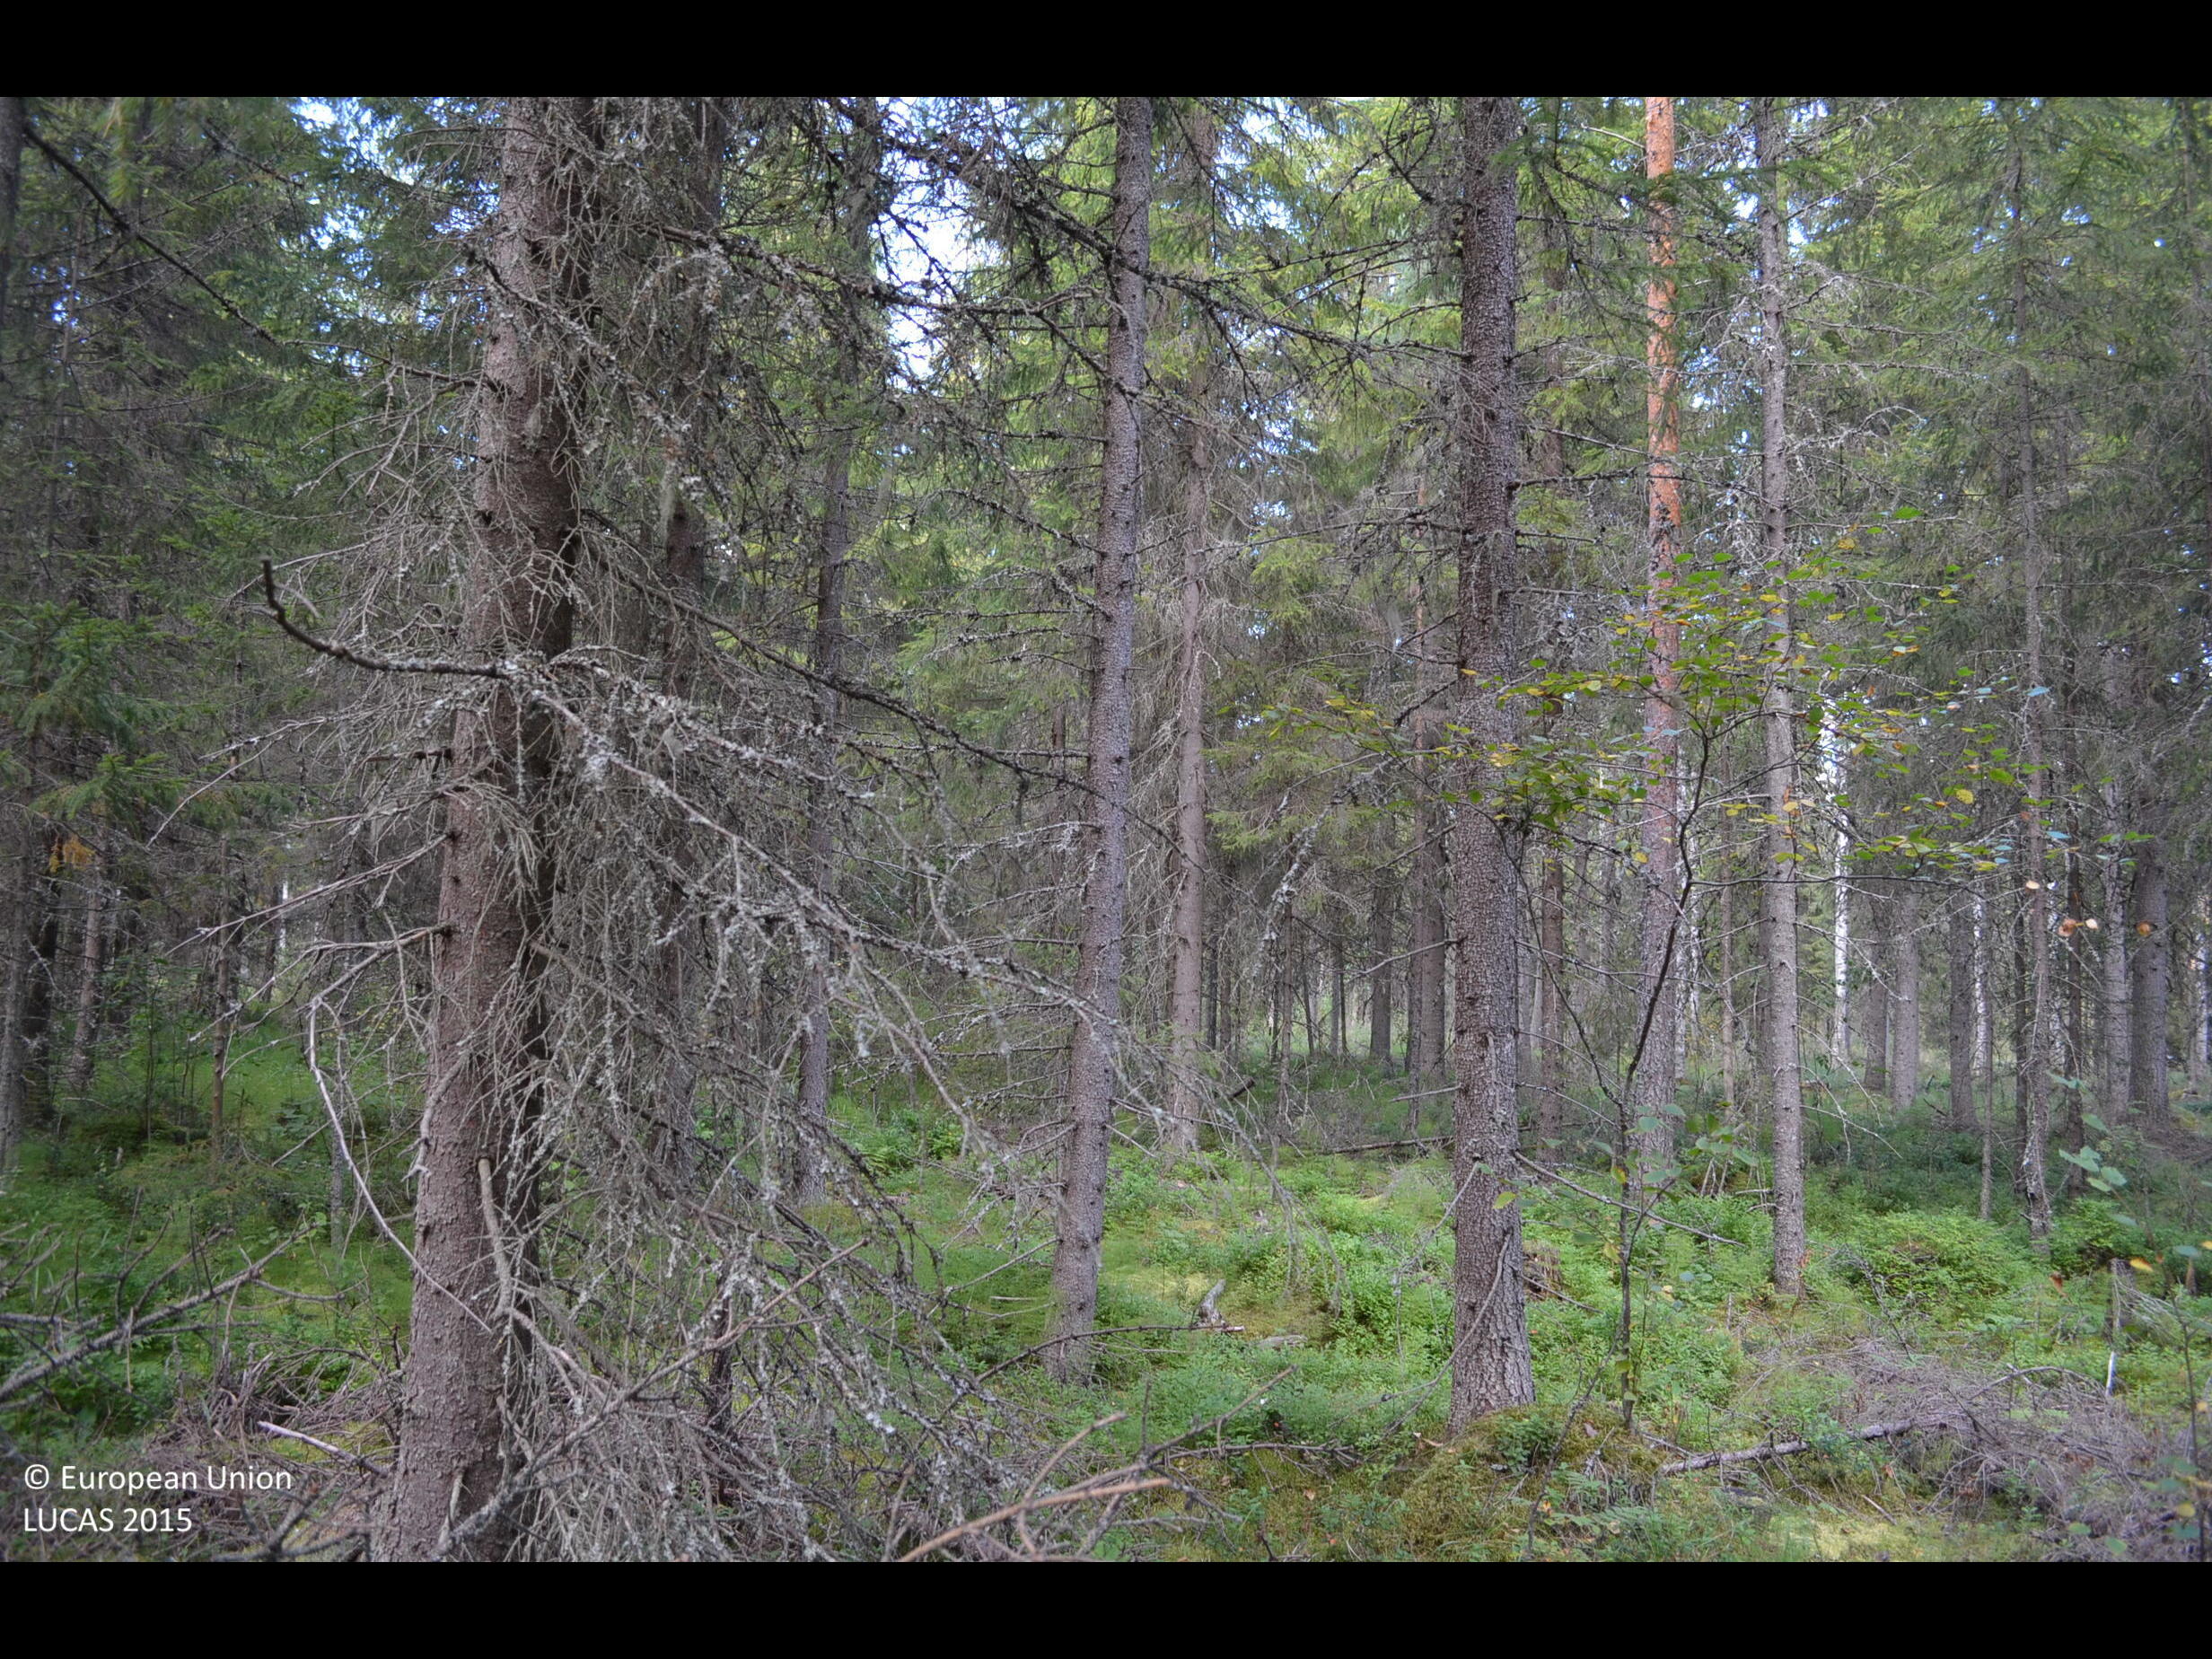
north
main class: Woodland
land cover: Other coniferous woodland
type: boreal forest
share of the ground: > 75 %
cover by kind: coniferous forest trees 70 %, shrubs 15 %, broadleaved forest trees 5 %, herbaceous plants 5 %, lichens and mosses 5 %
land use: Forestry
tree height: > 5 m
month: August
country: FI
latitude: 62.3779
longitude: 23.5878
